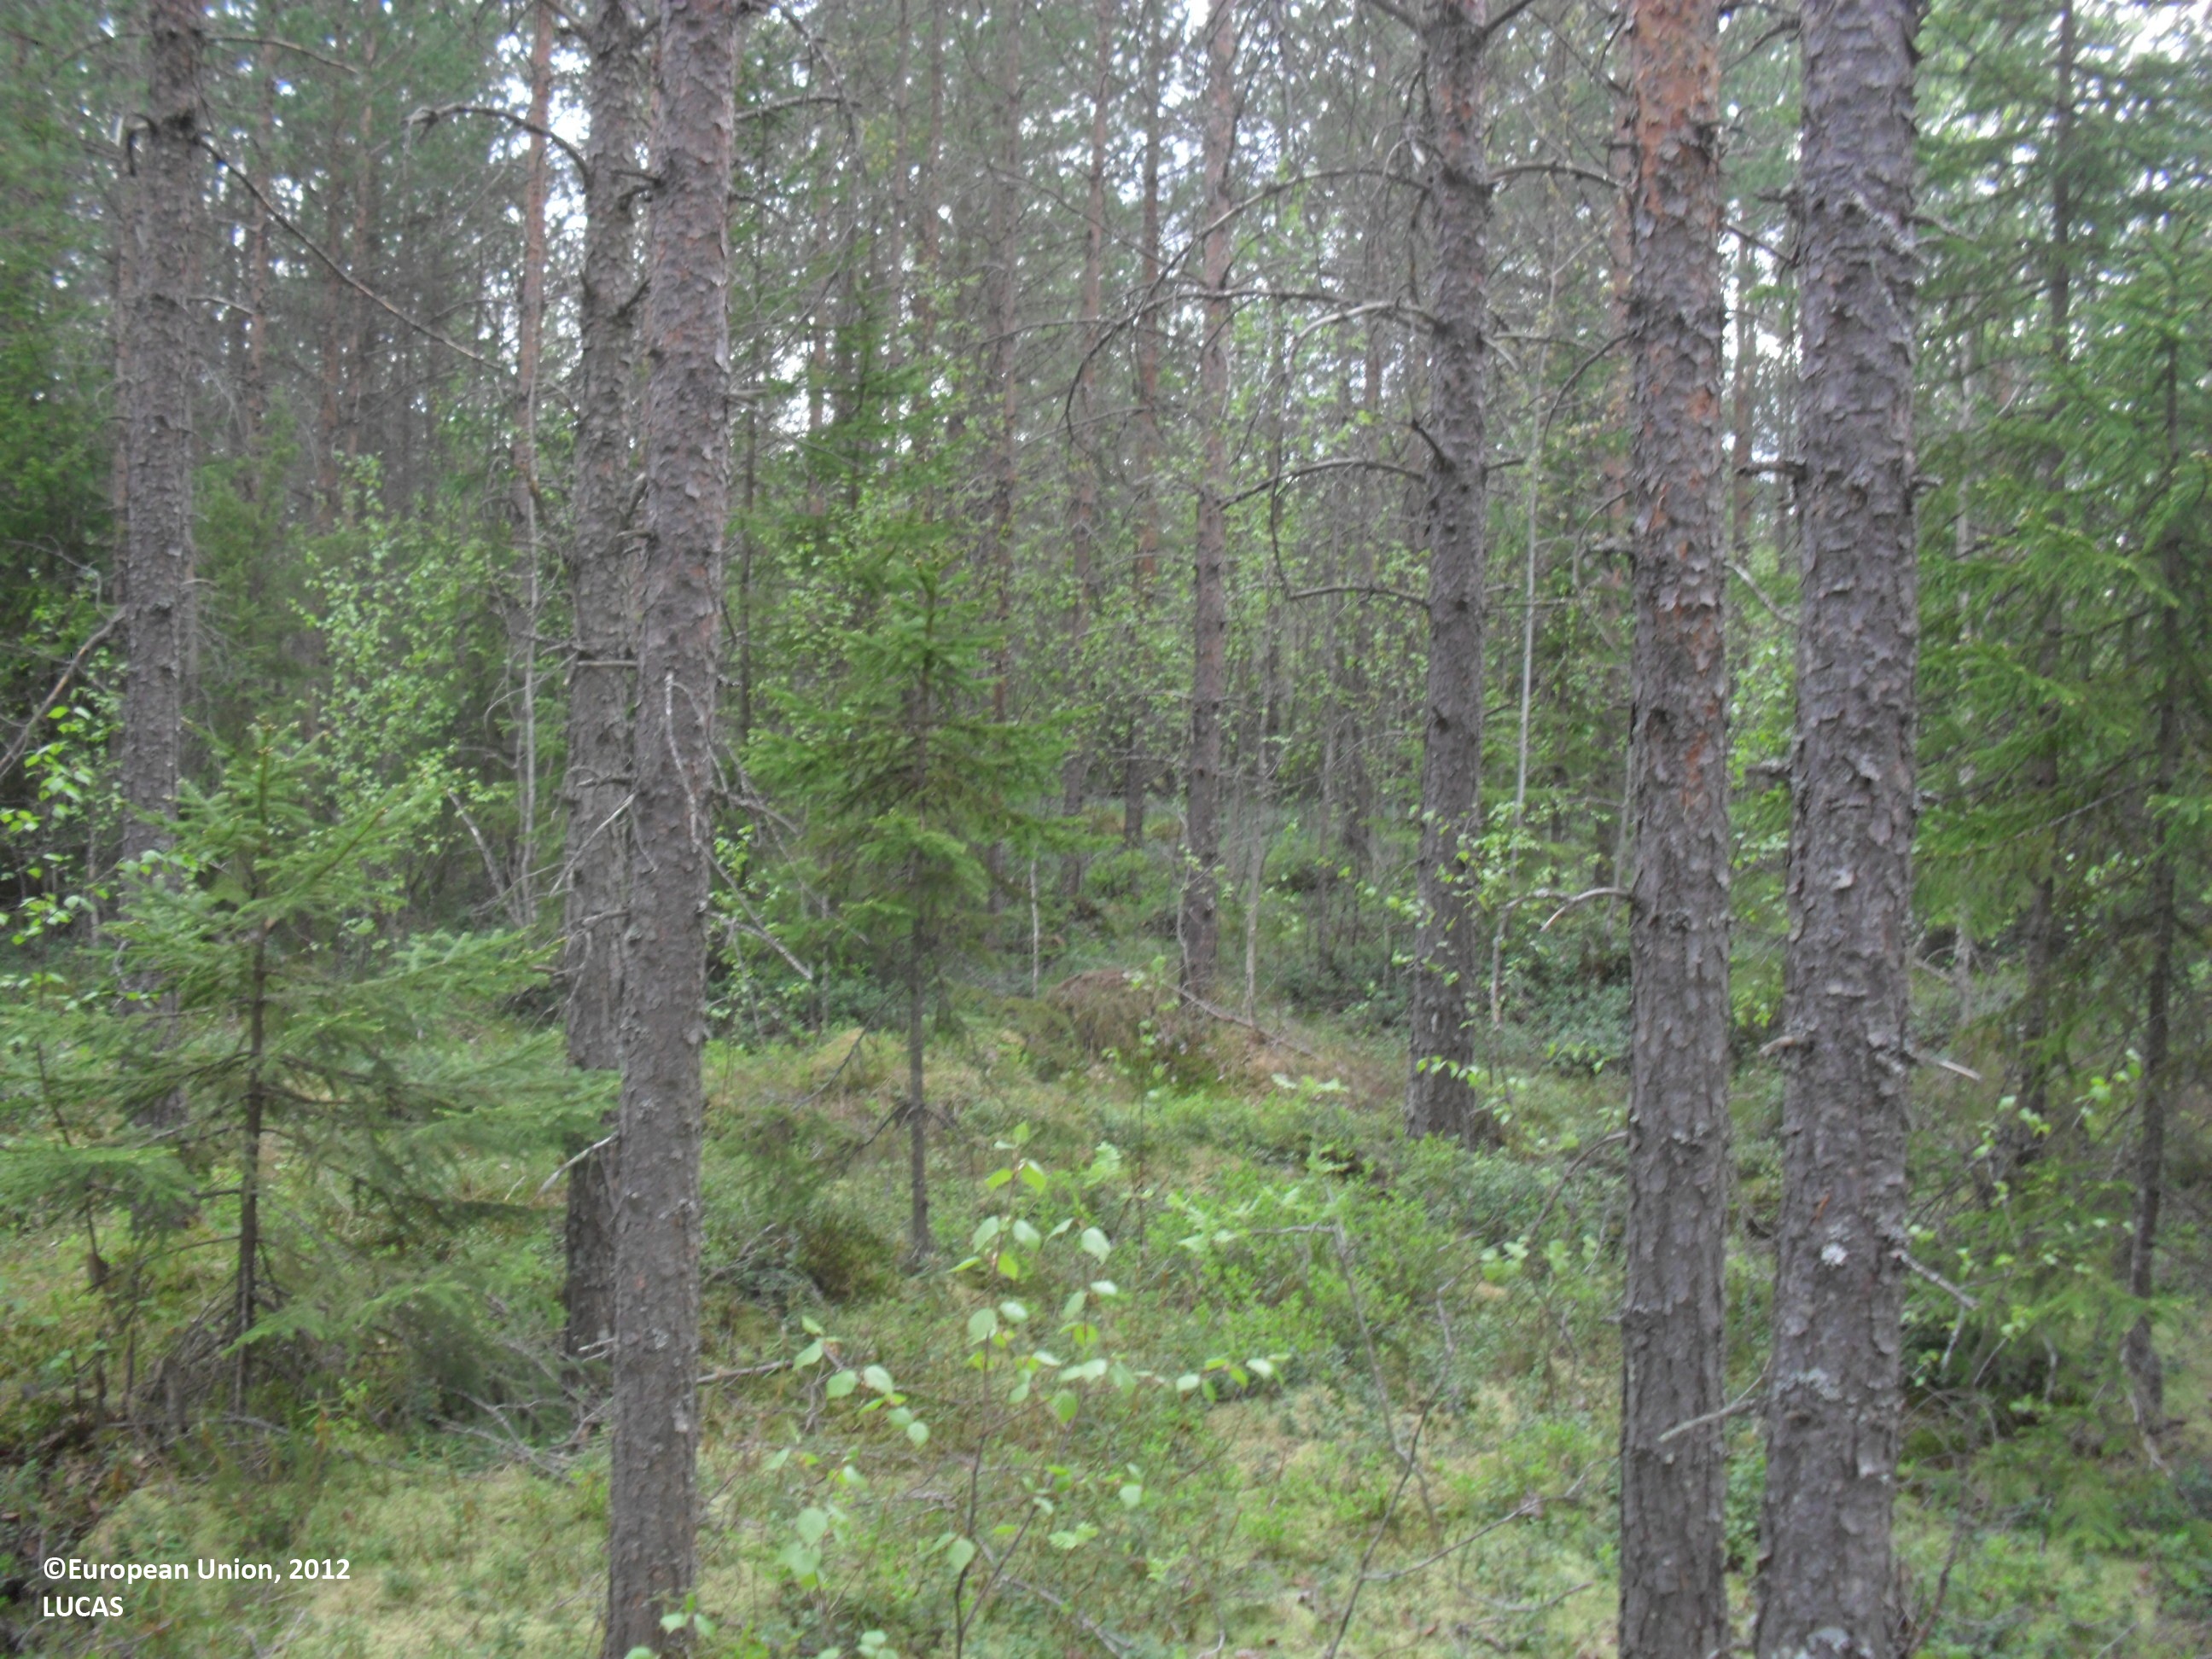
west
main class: Woodland
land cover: Pine dominated coniferous woodland
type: boreal forest
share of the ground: 50 - 75 %
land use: Forestry
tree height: > 5 m
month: May
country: FI
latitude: 63.2645
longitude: 23.1082
